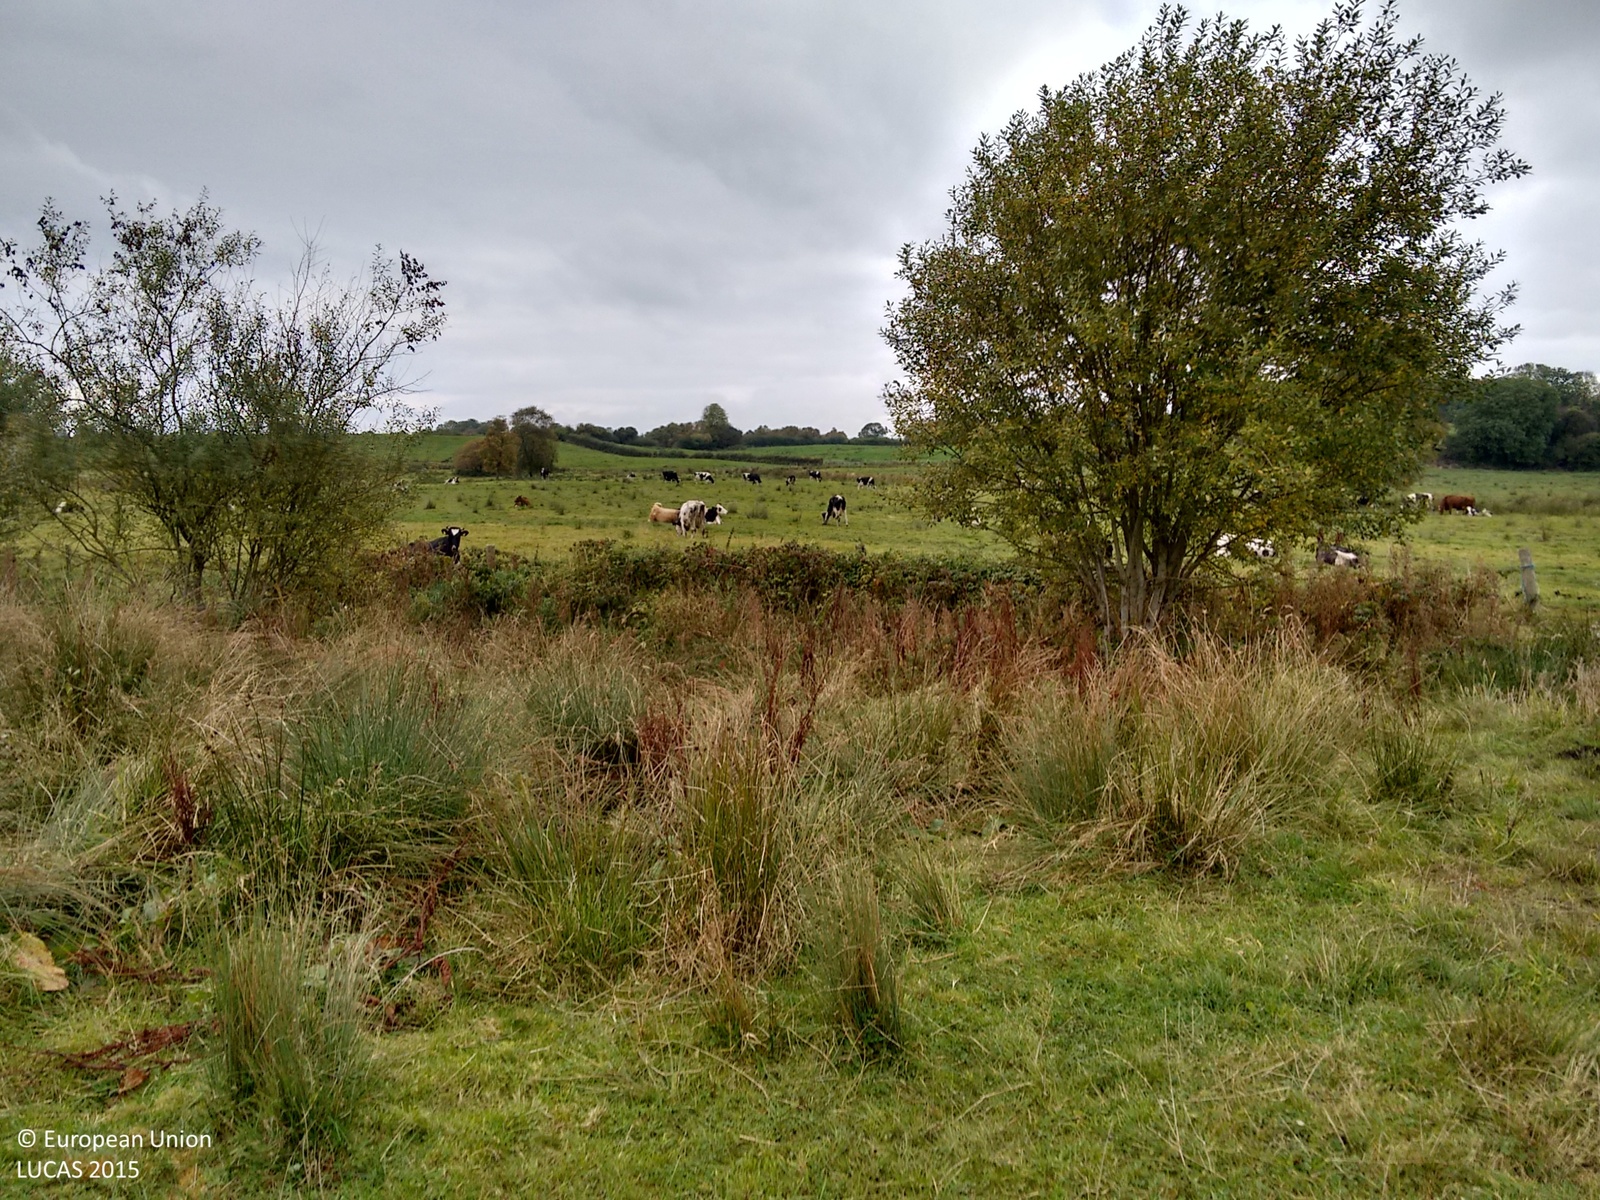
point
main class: Grassland
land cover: Grassland without tree/shrub cover
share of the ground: > 75 %
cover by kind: herbaceous plants 100 %
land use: Agriculture (excluding fallow land and kitchen gardens)
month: October
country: GB
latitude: 54.2791
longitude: -7.4326
